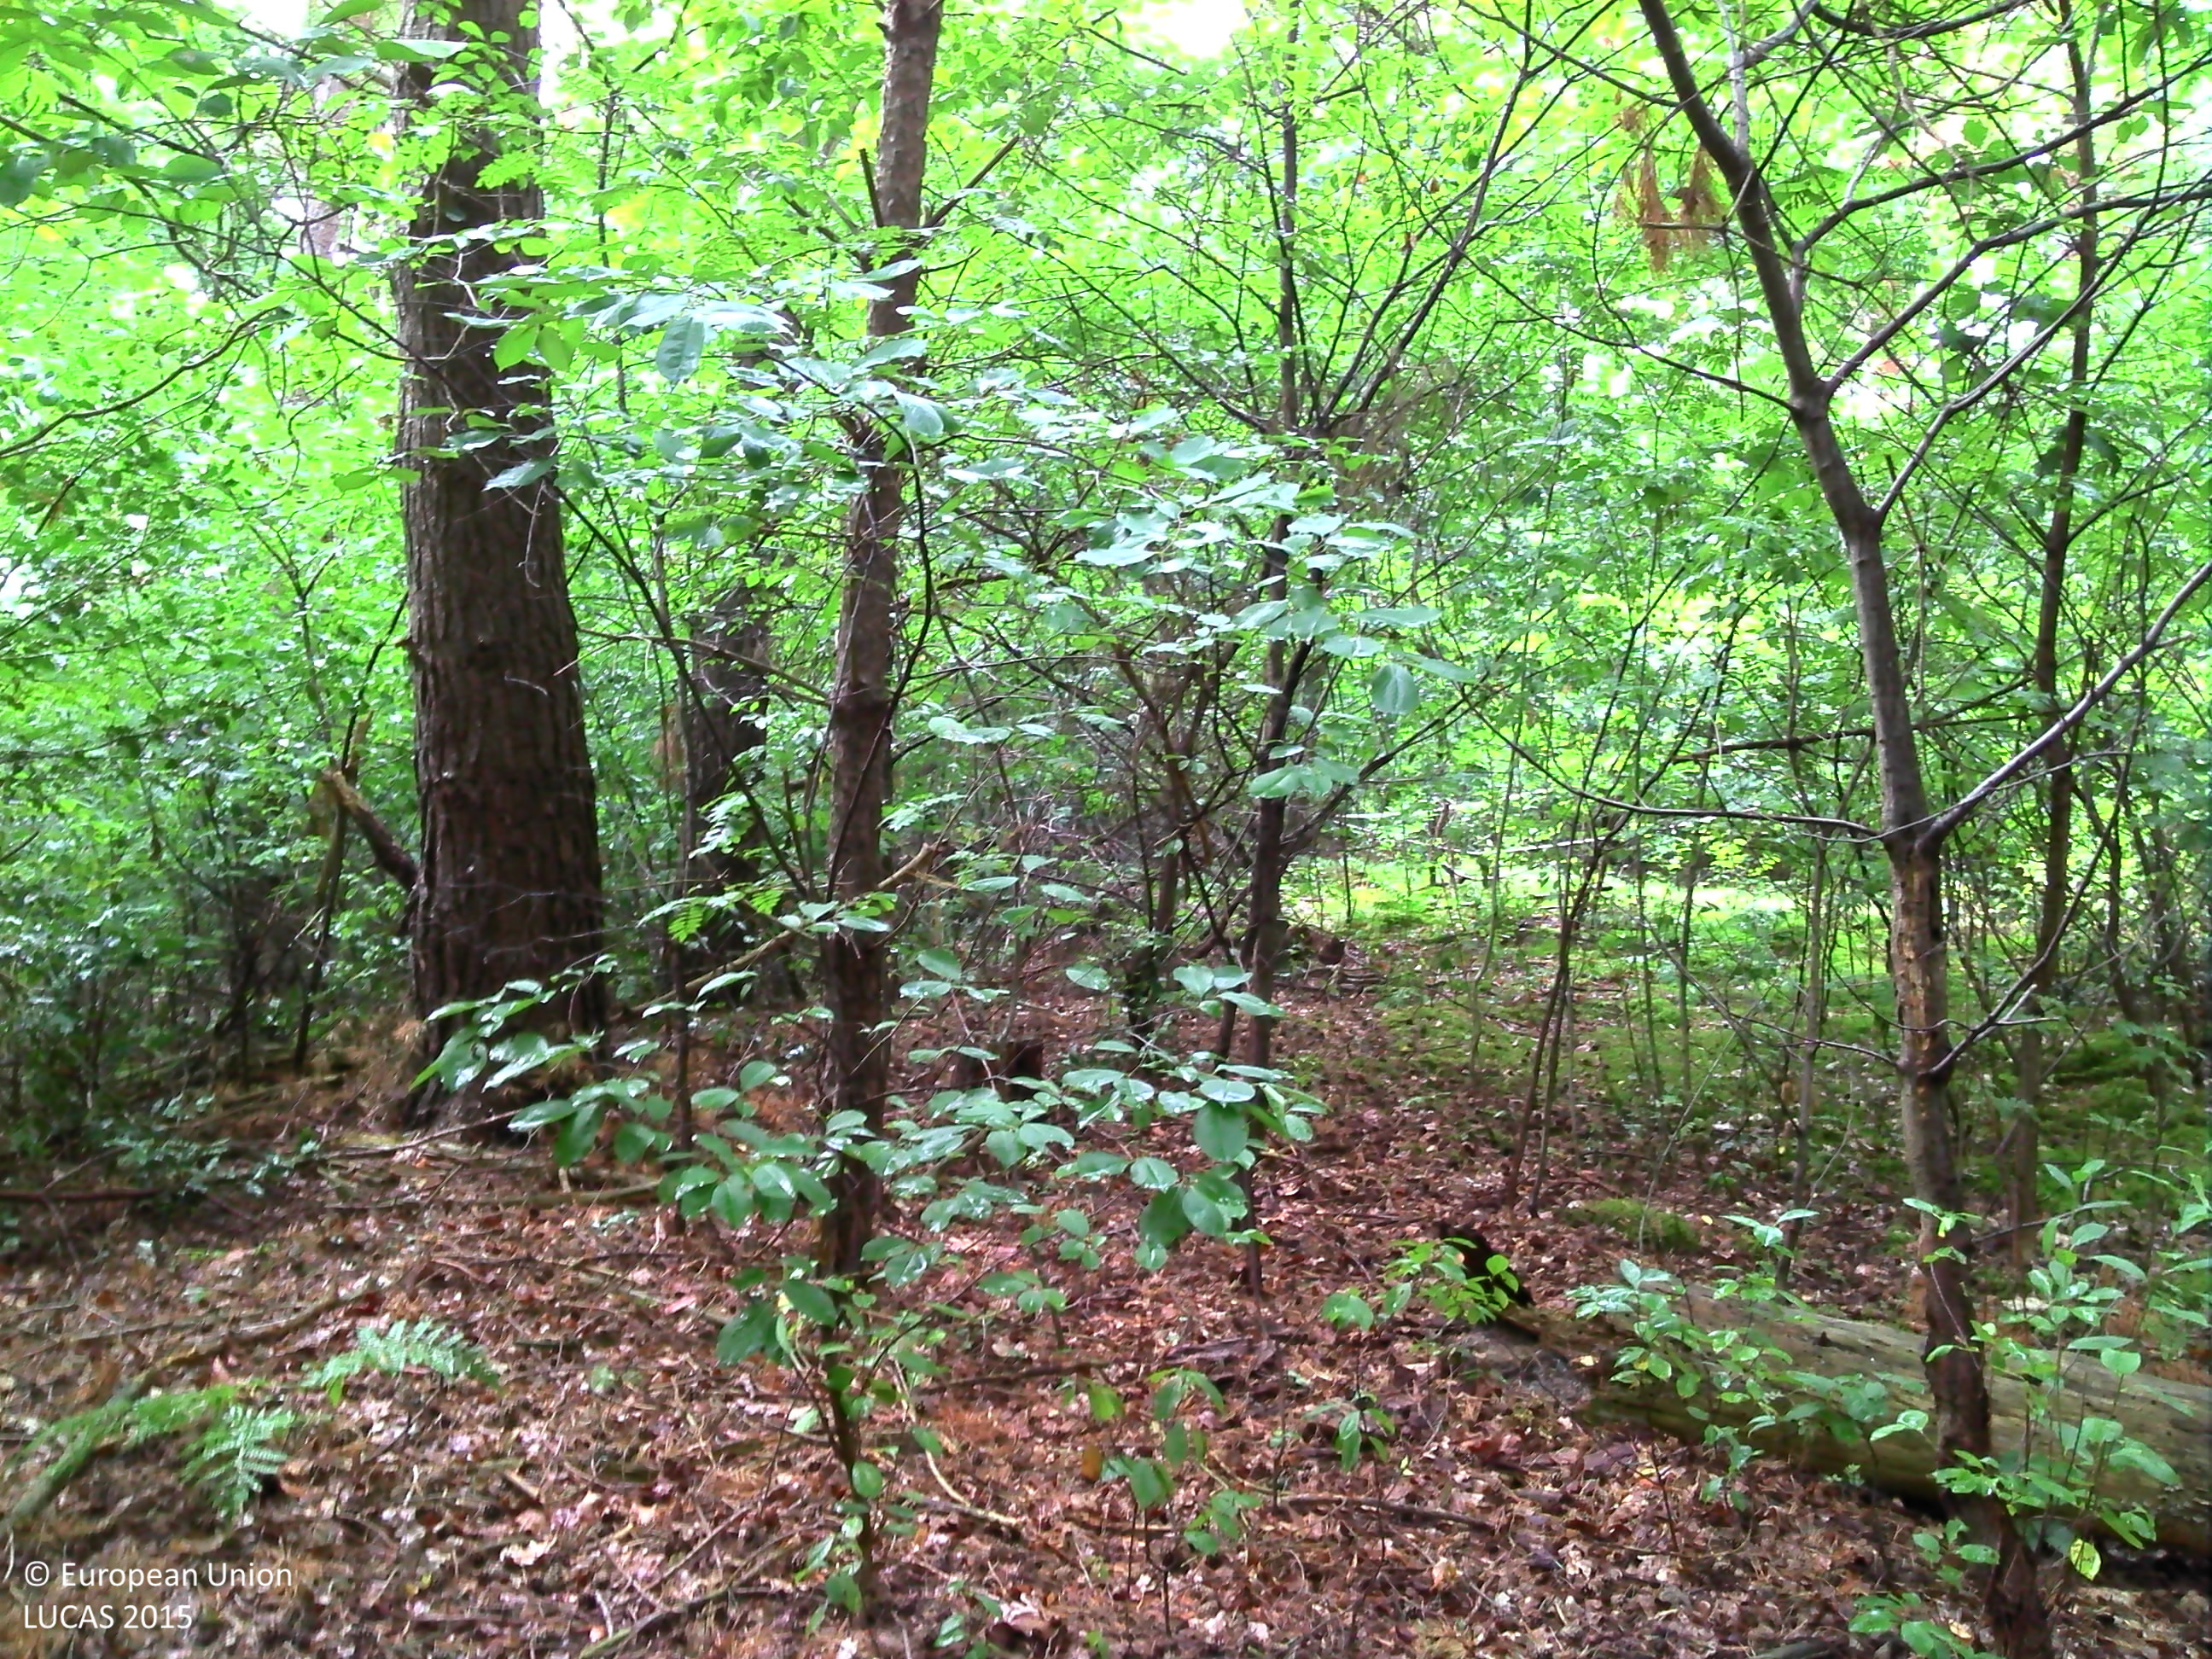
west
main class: Woodland
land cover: Pine dominated mixed woodland
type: hemiboreal forest and nemoral coniferous forest and mixed broadleaved-coniferous forest
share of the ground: > 75 %
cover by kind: coniferous forest trees 60 %, broadleaved forest trees 40 %
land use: Forestry
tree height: > 5 m
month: August
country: BE
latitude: 50.9425
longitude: 5.5151
